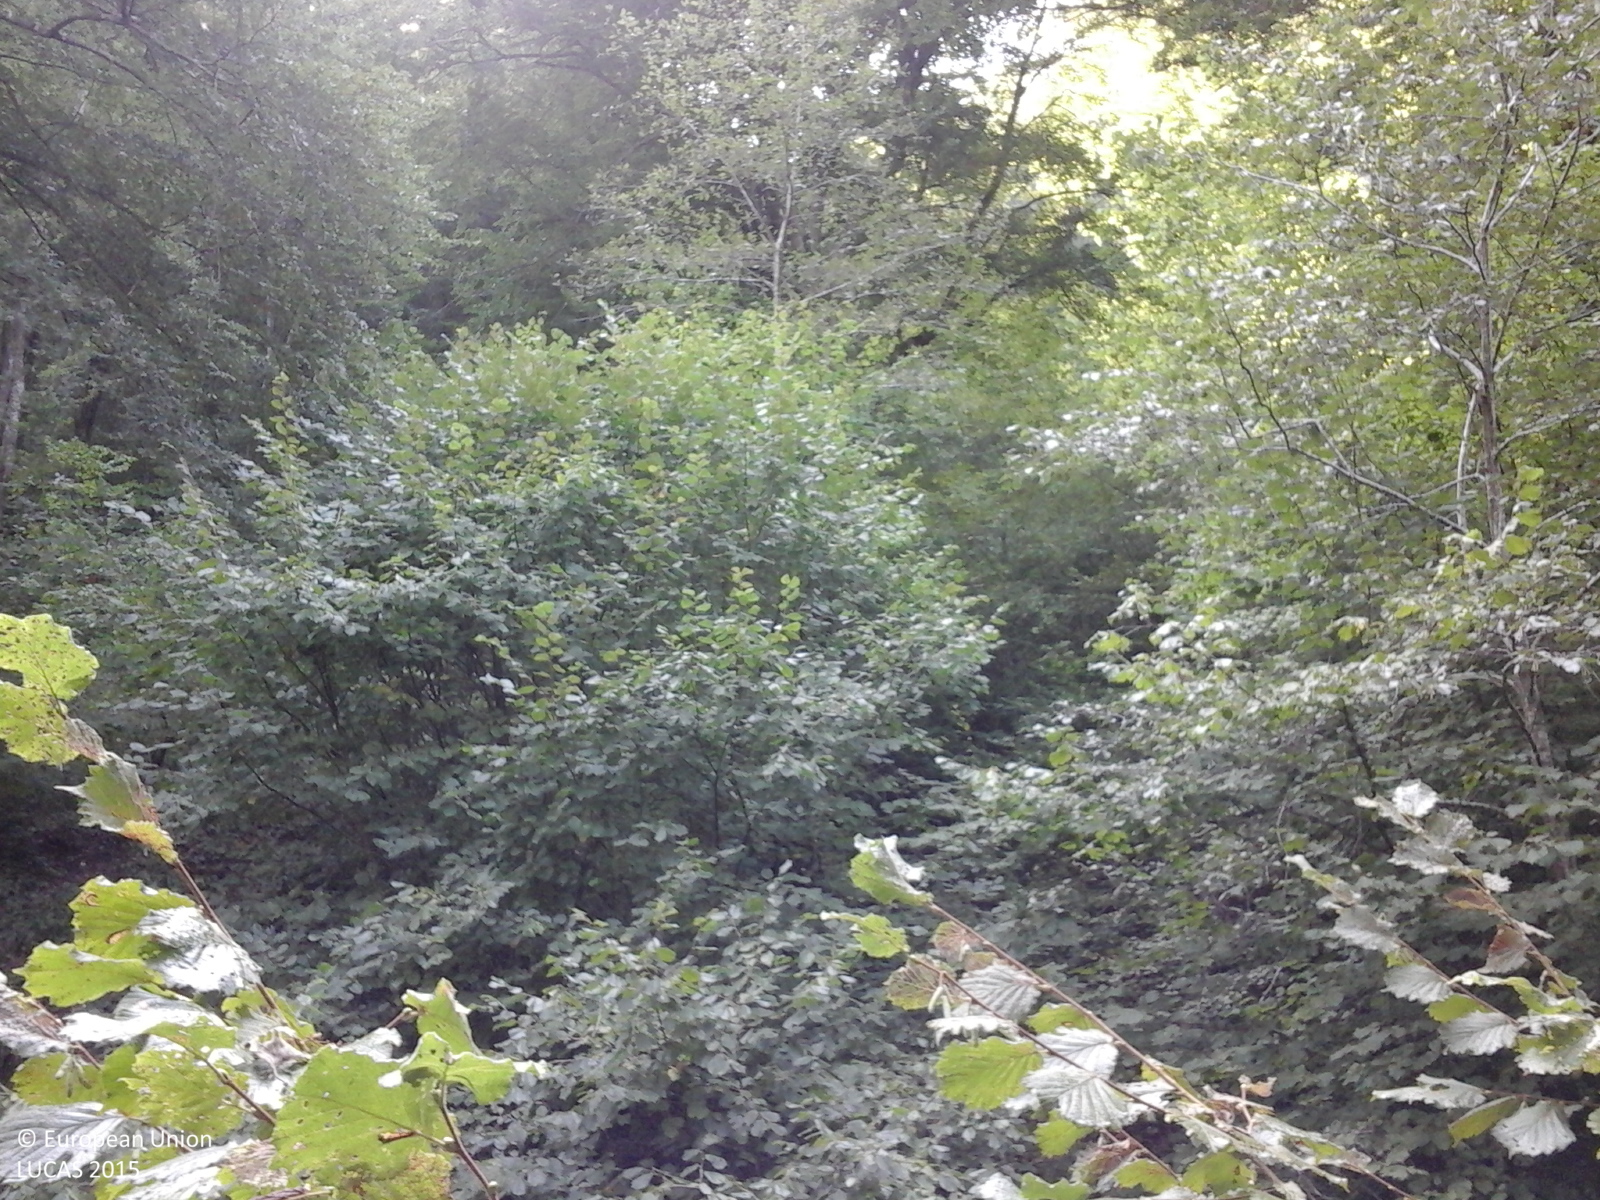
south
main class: Woodland
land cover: Broadleaved woodland
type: beech forest
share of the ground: > 75 %
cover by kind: broadleaved forest trees 100 %
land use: Forestry
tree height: > 5 m
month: September
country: RO
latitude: 45.5906
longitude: 22.7005
